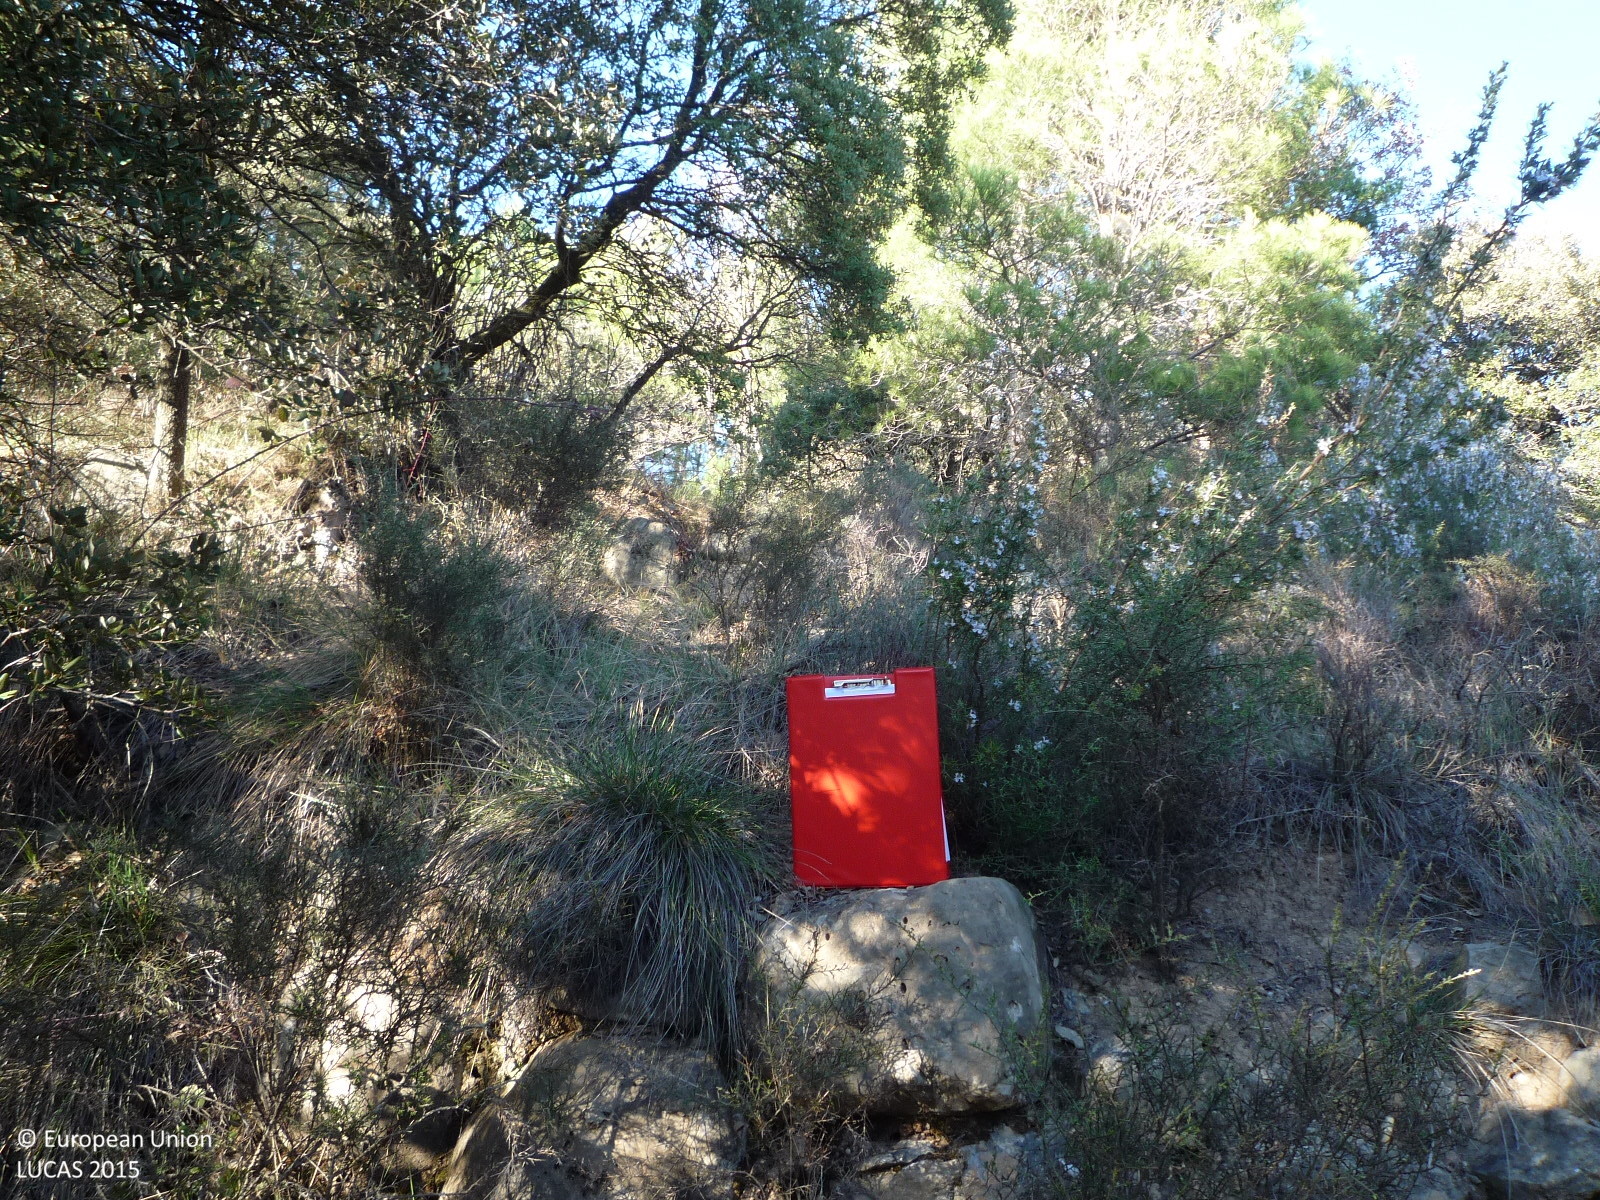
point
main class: Woodland
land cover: Broadleaved woodland
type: broadleaved evergreen forest
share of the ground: > 75 %
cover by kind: broadleaved forest trees 40 %, shrubs 40 %, herbaceous plants 20 %
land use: Semi-natural and natural areas not in use
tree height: < 5 m
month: March
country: ES
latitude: 42.0418
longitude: 1.7134
